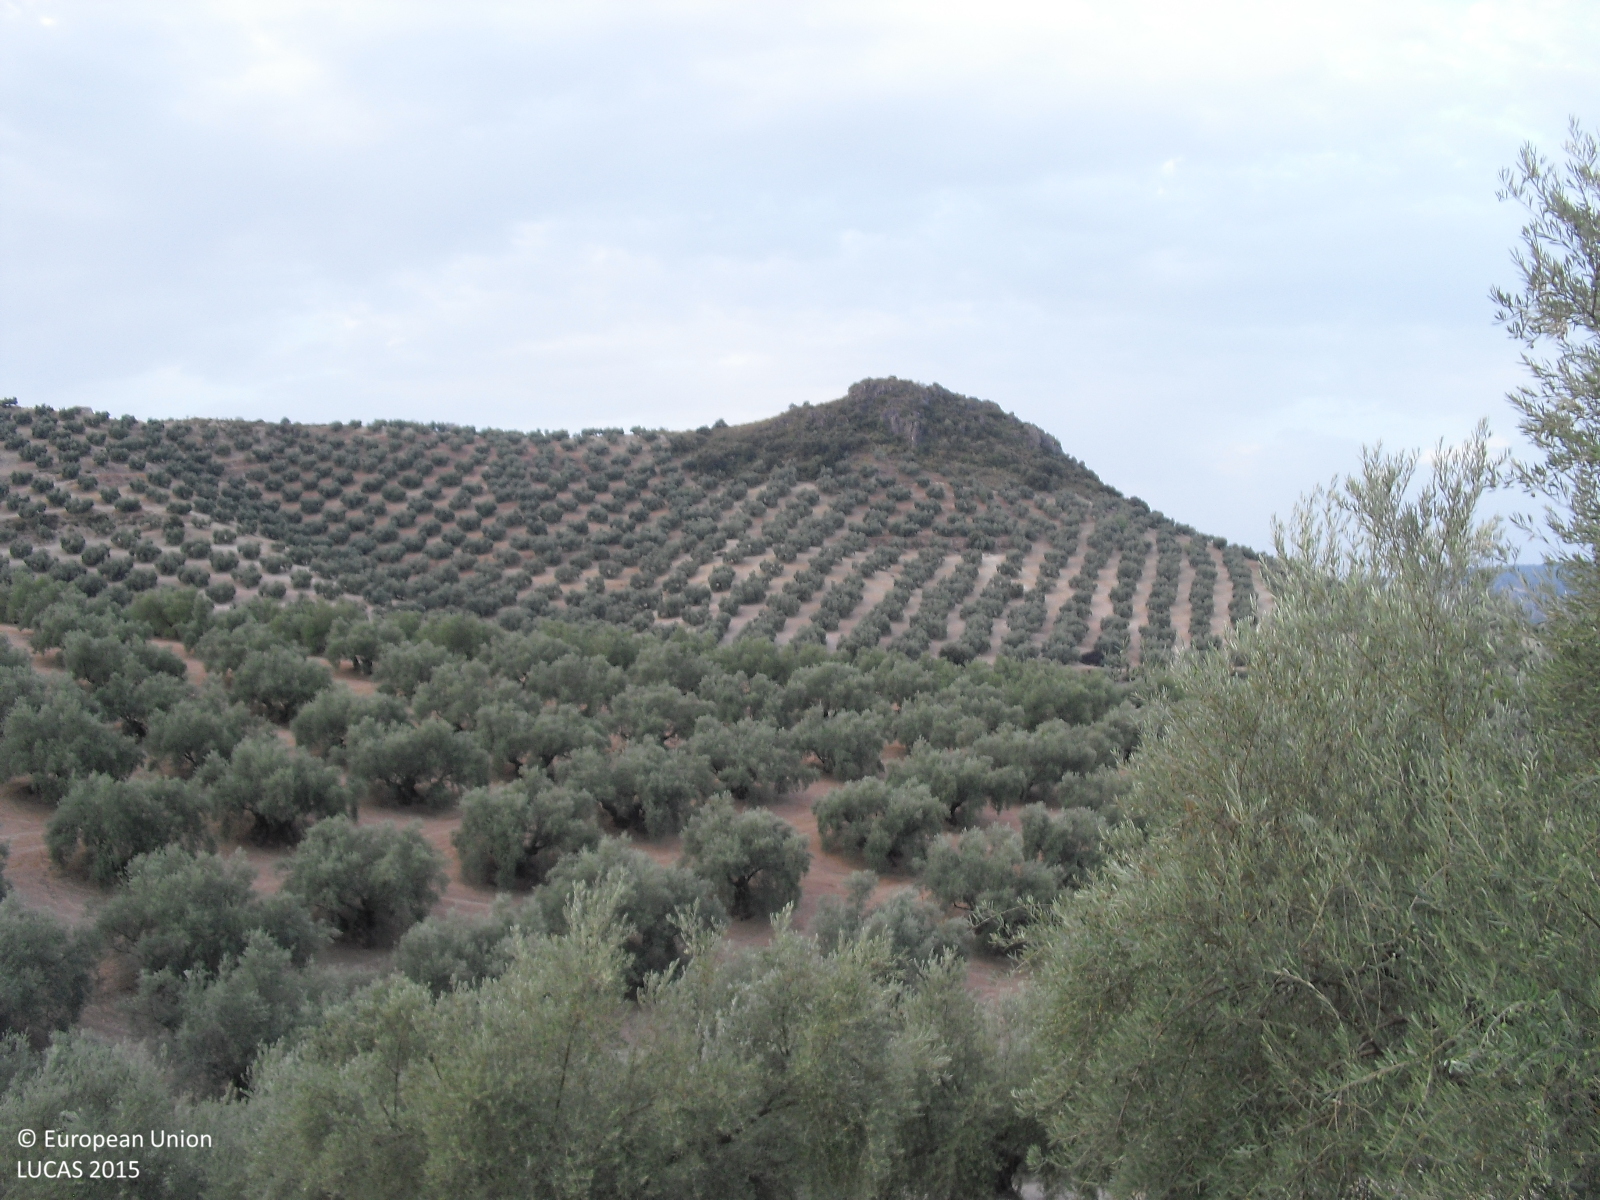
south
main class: Cropland
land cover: Olive groves
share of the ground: 25 - 50 %
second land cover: Other bare soil
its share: > 75 %
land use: Agriculture (excluding fallow land and kitchen gardens)
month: August
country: ES
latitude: 37.2984
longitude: -4.3374
